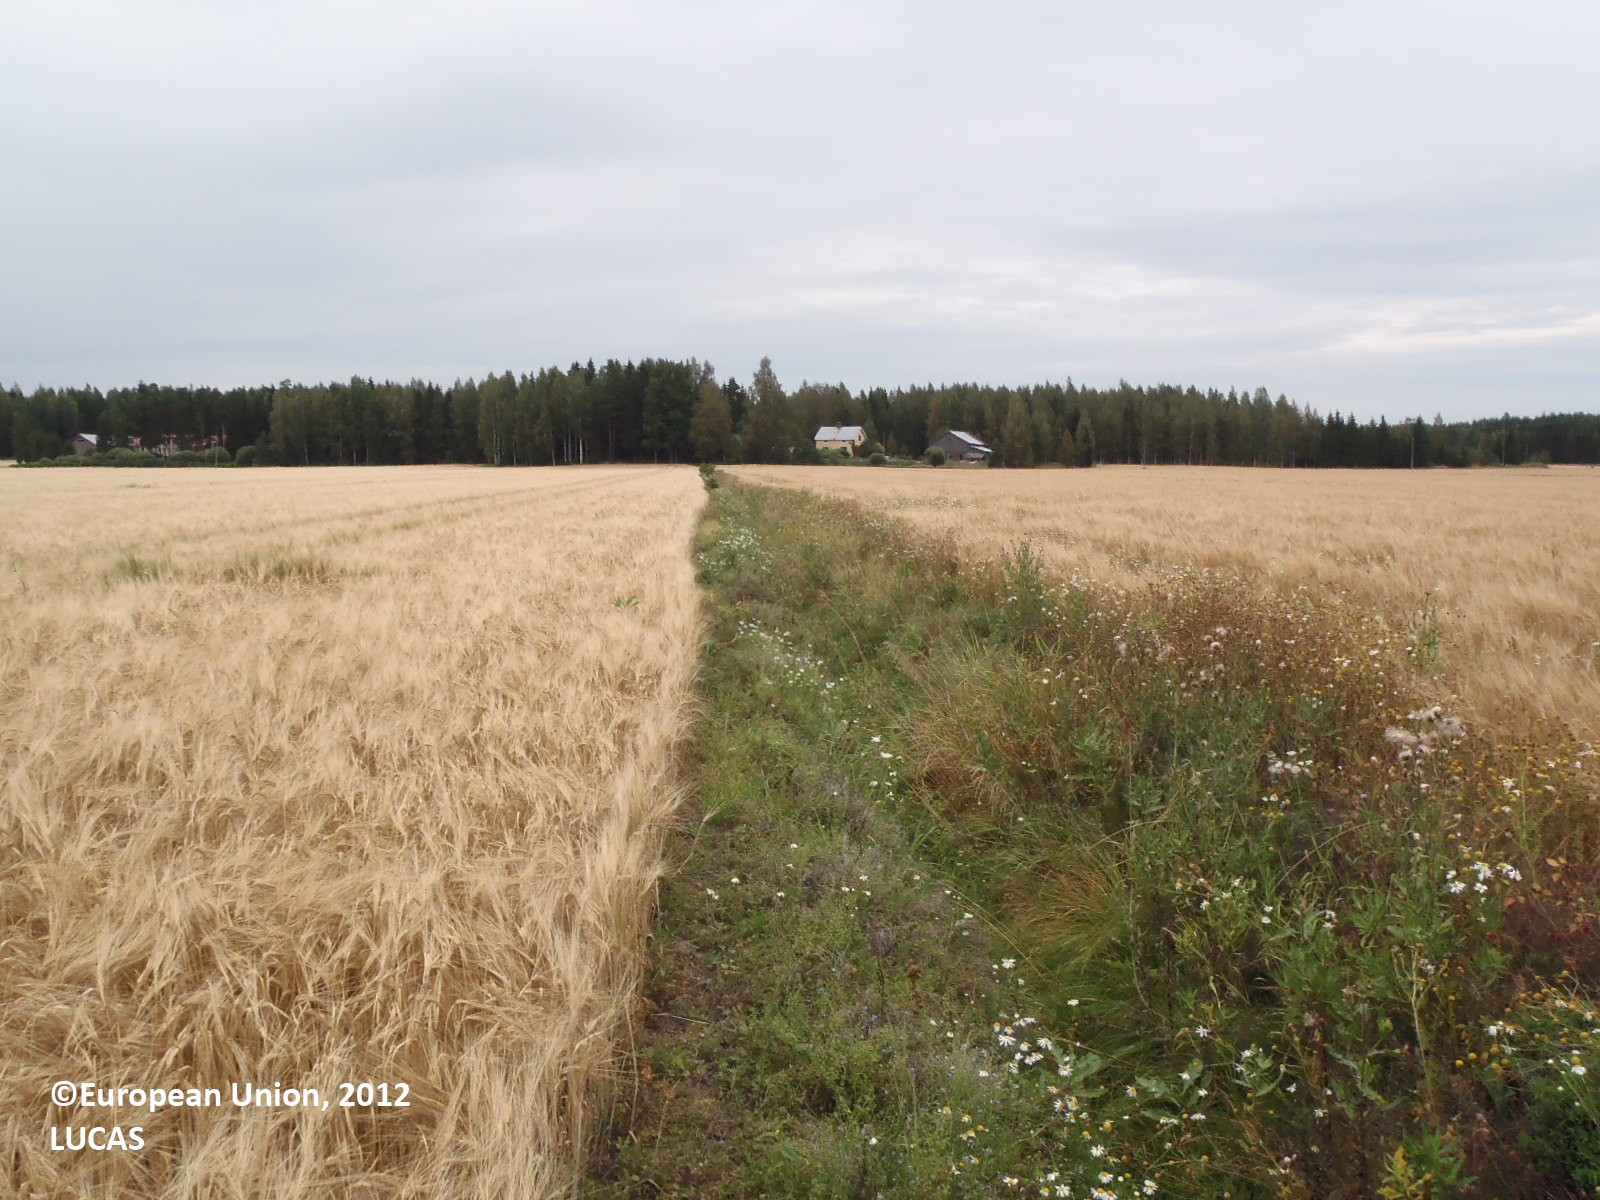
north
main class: Cropland
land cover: Barley
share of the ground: > 75 %
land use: Agriculture (excluding fallow land and kitchen gardens)
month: August
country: FI
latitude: 60.8194
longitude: 22.5908
